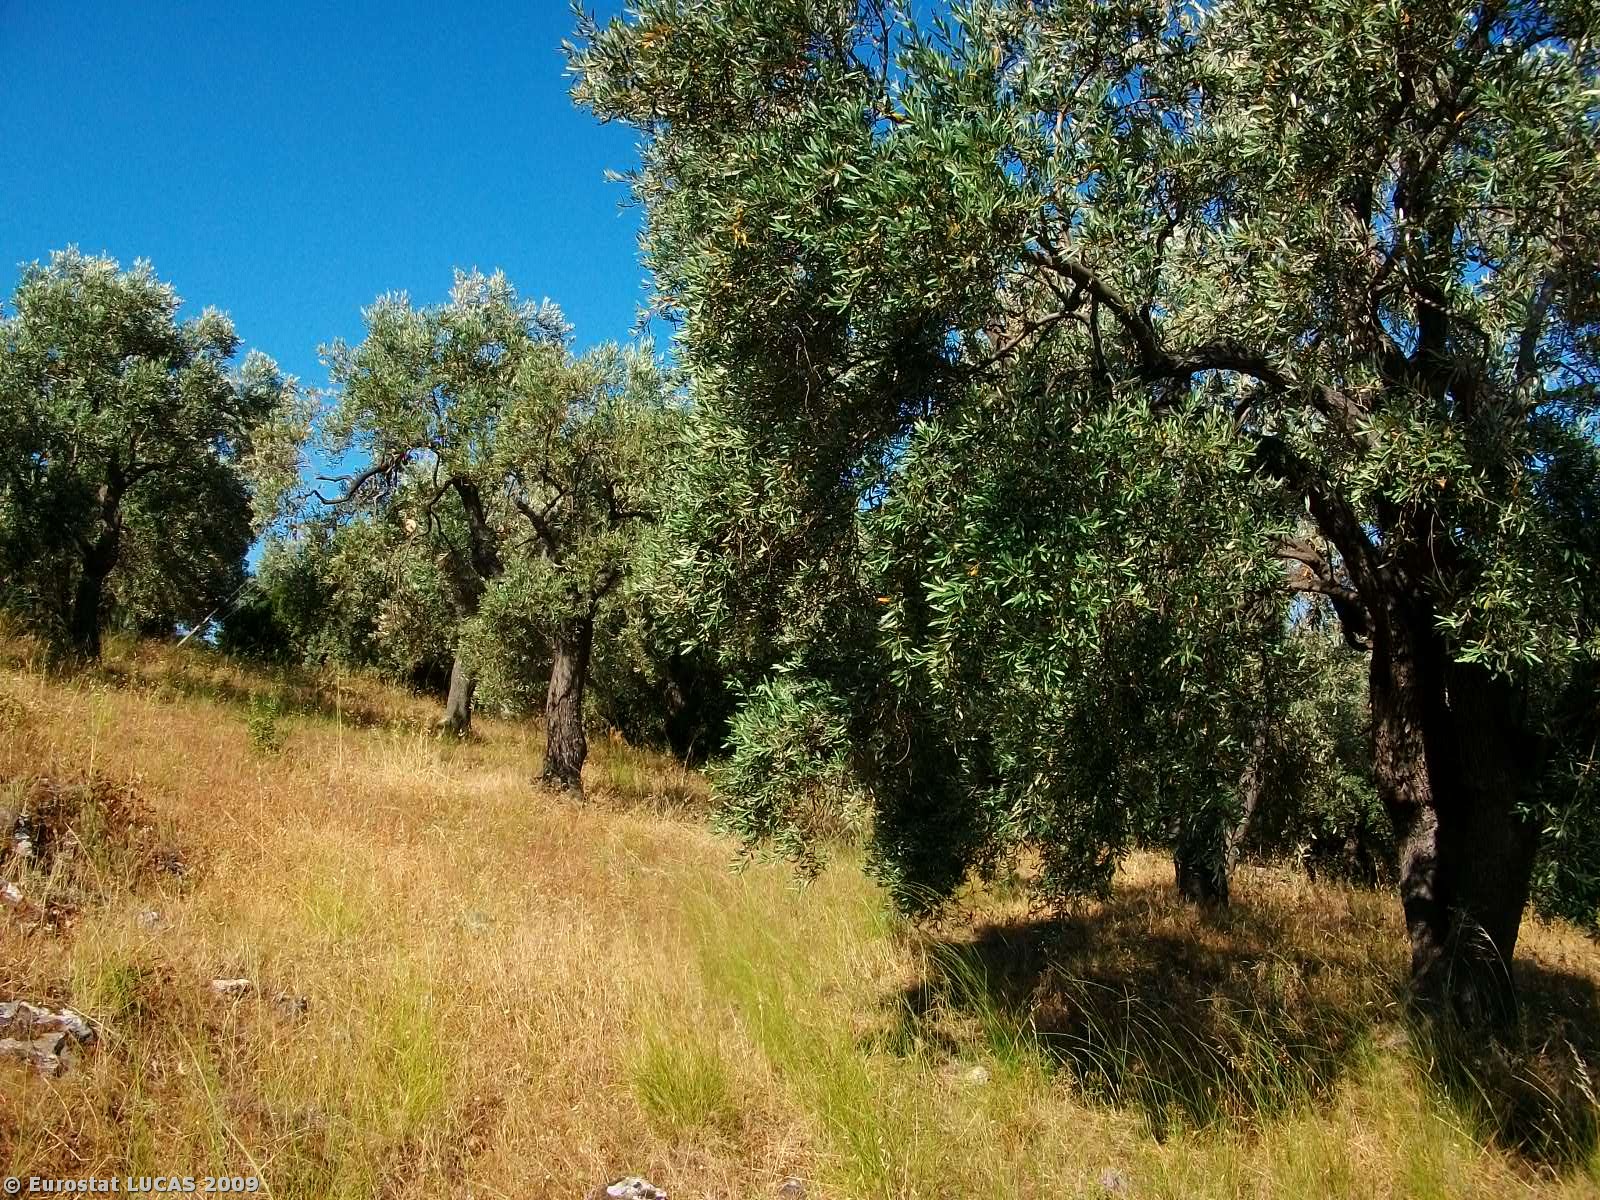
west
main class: Cropland
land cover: Olive groves
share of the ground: 50 - 75 %
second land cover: Grassland with sparse tree/shrub cover
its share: > 75 %
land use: Agriculture (excluding fallow land and kitchen gardens)
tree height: < 5 m
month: June
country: GR
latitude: 39.1669
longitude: 23.2208
